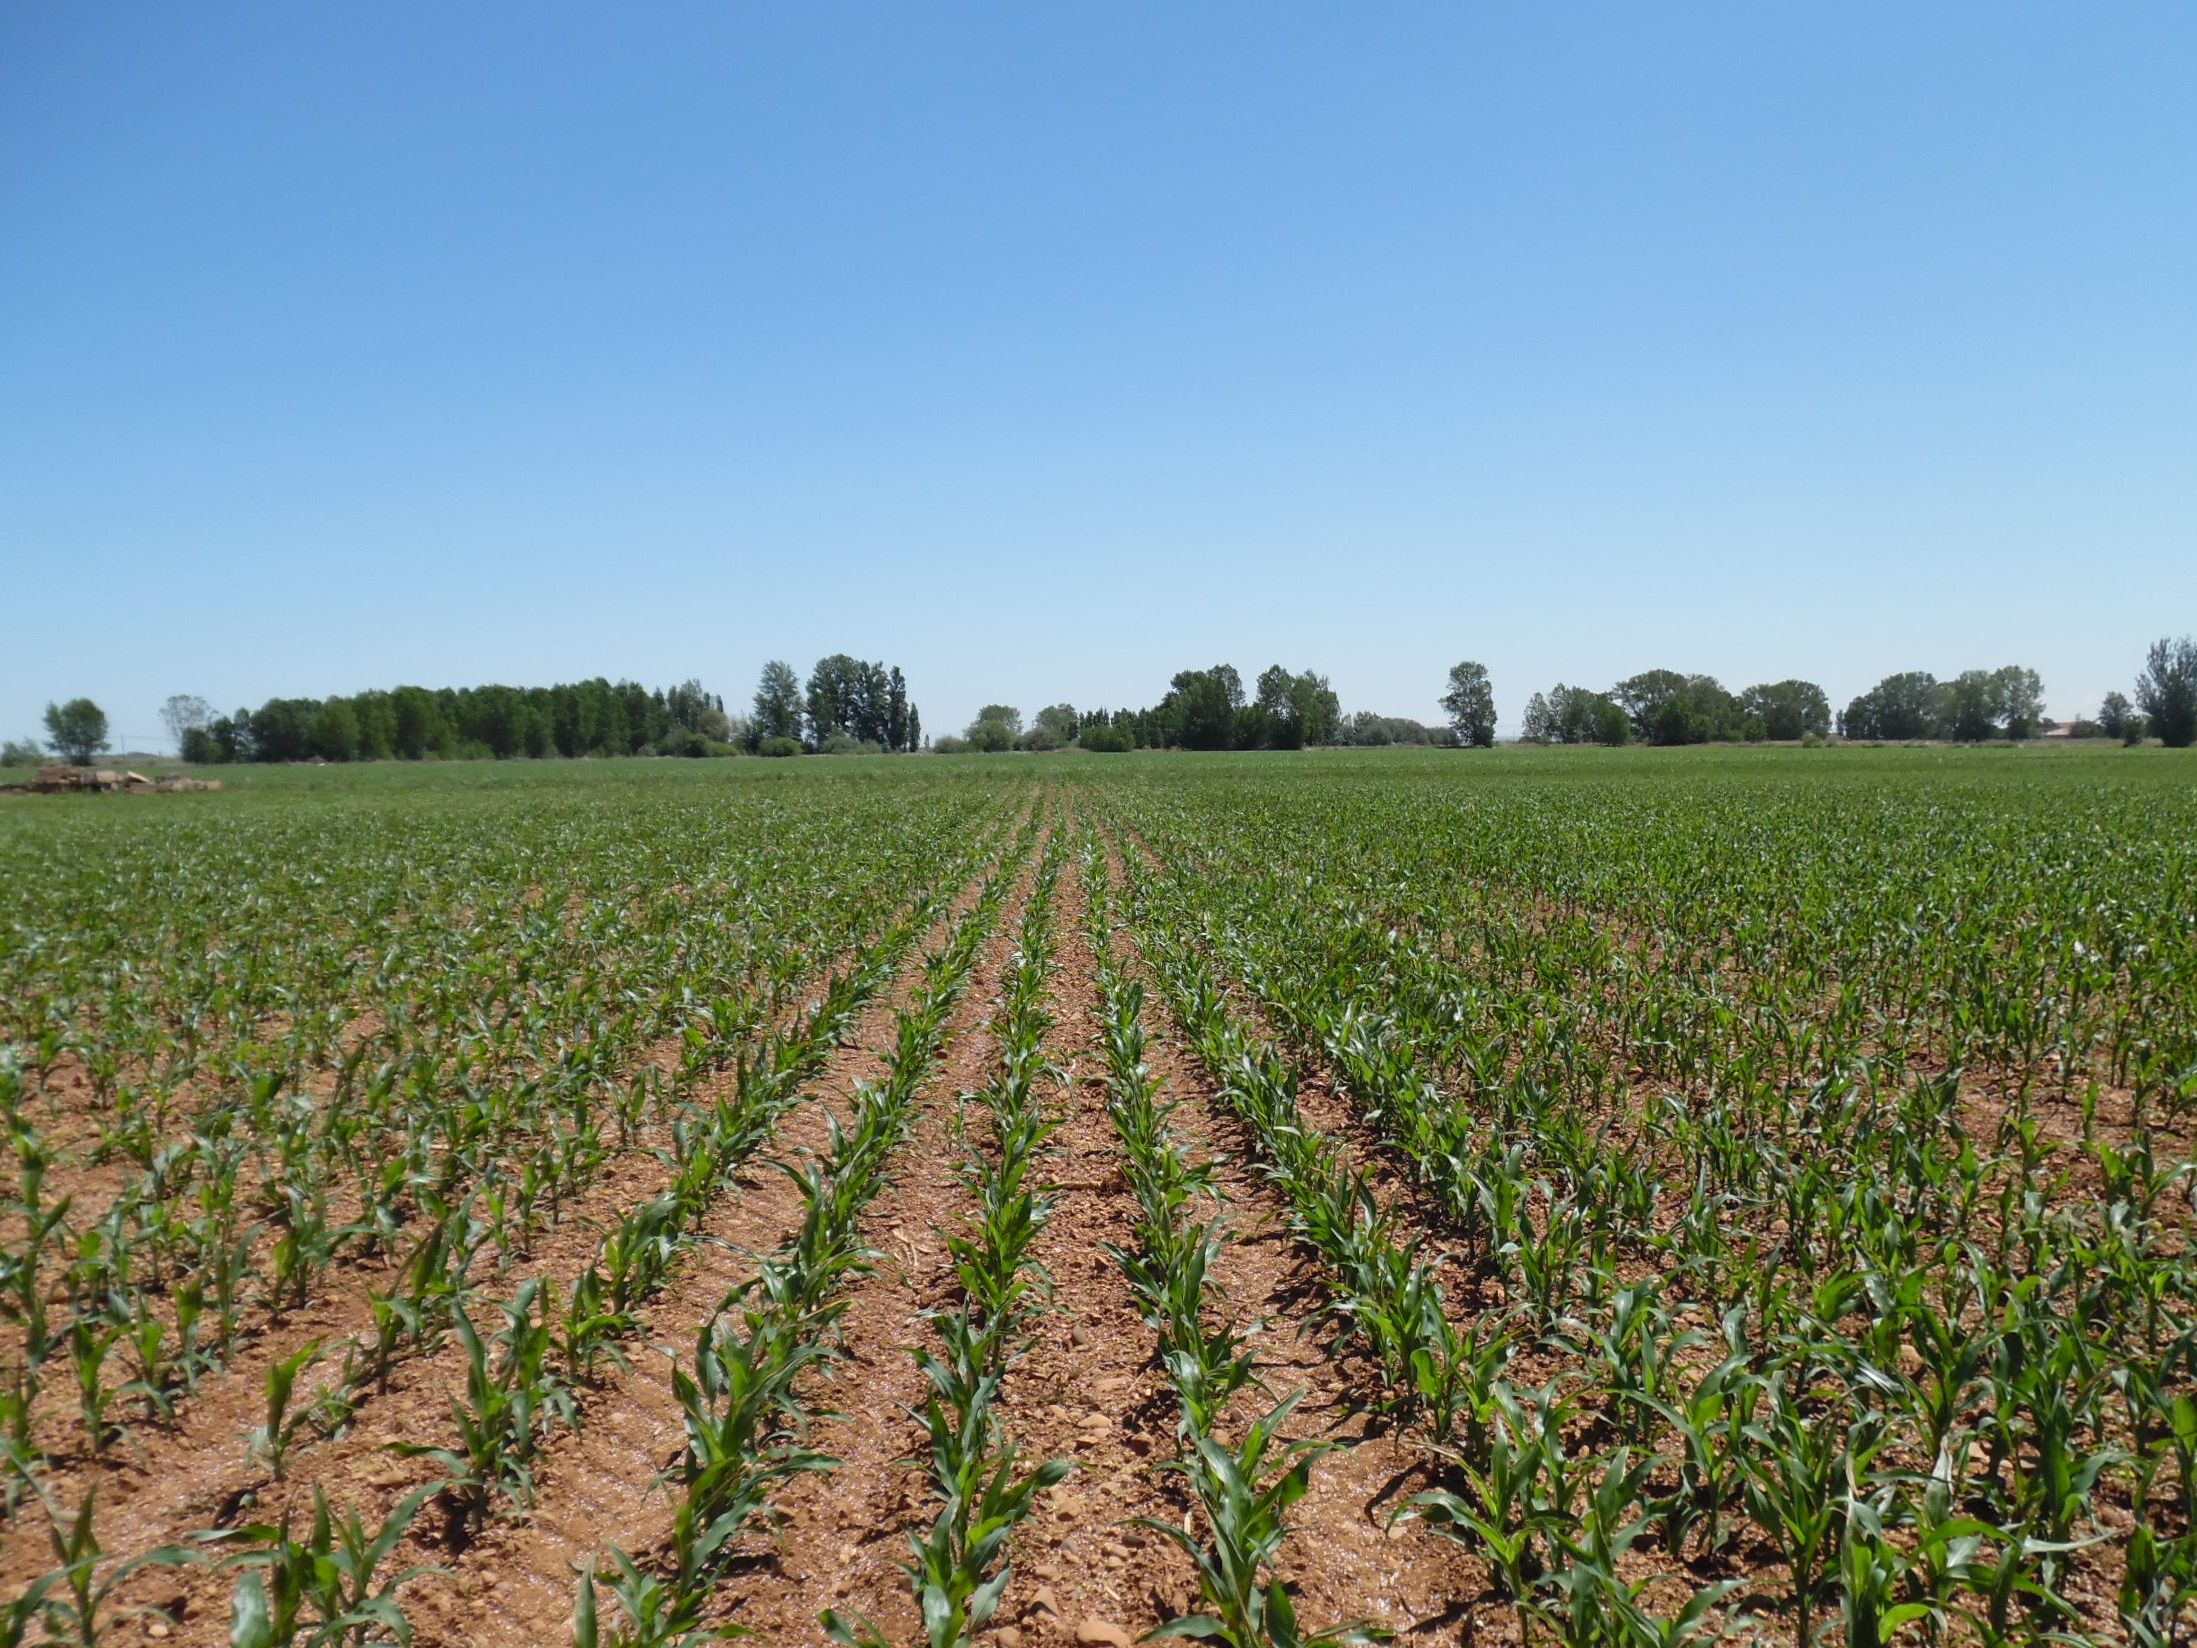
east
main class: Cropland
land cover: Maize
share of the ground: 50 - 75 %
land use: Agriculture (excluding fallow land and kitchen gardens)
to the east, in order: Maize; Spontaneously vegetated surfaces; Maize
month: June
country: ES
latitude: 42.3576
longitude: -5.6980
